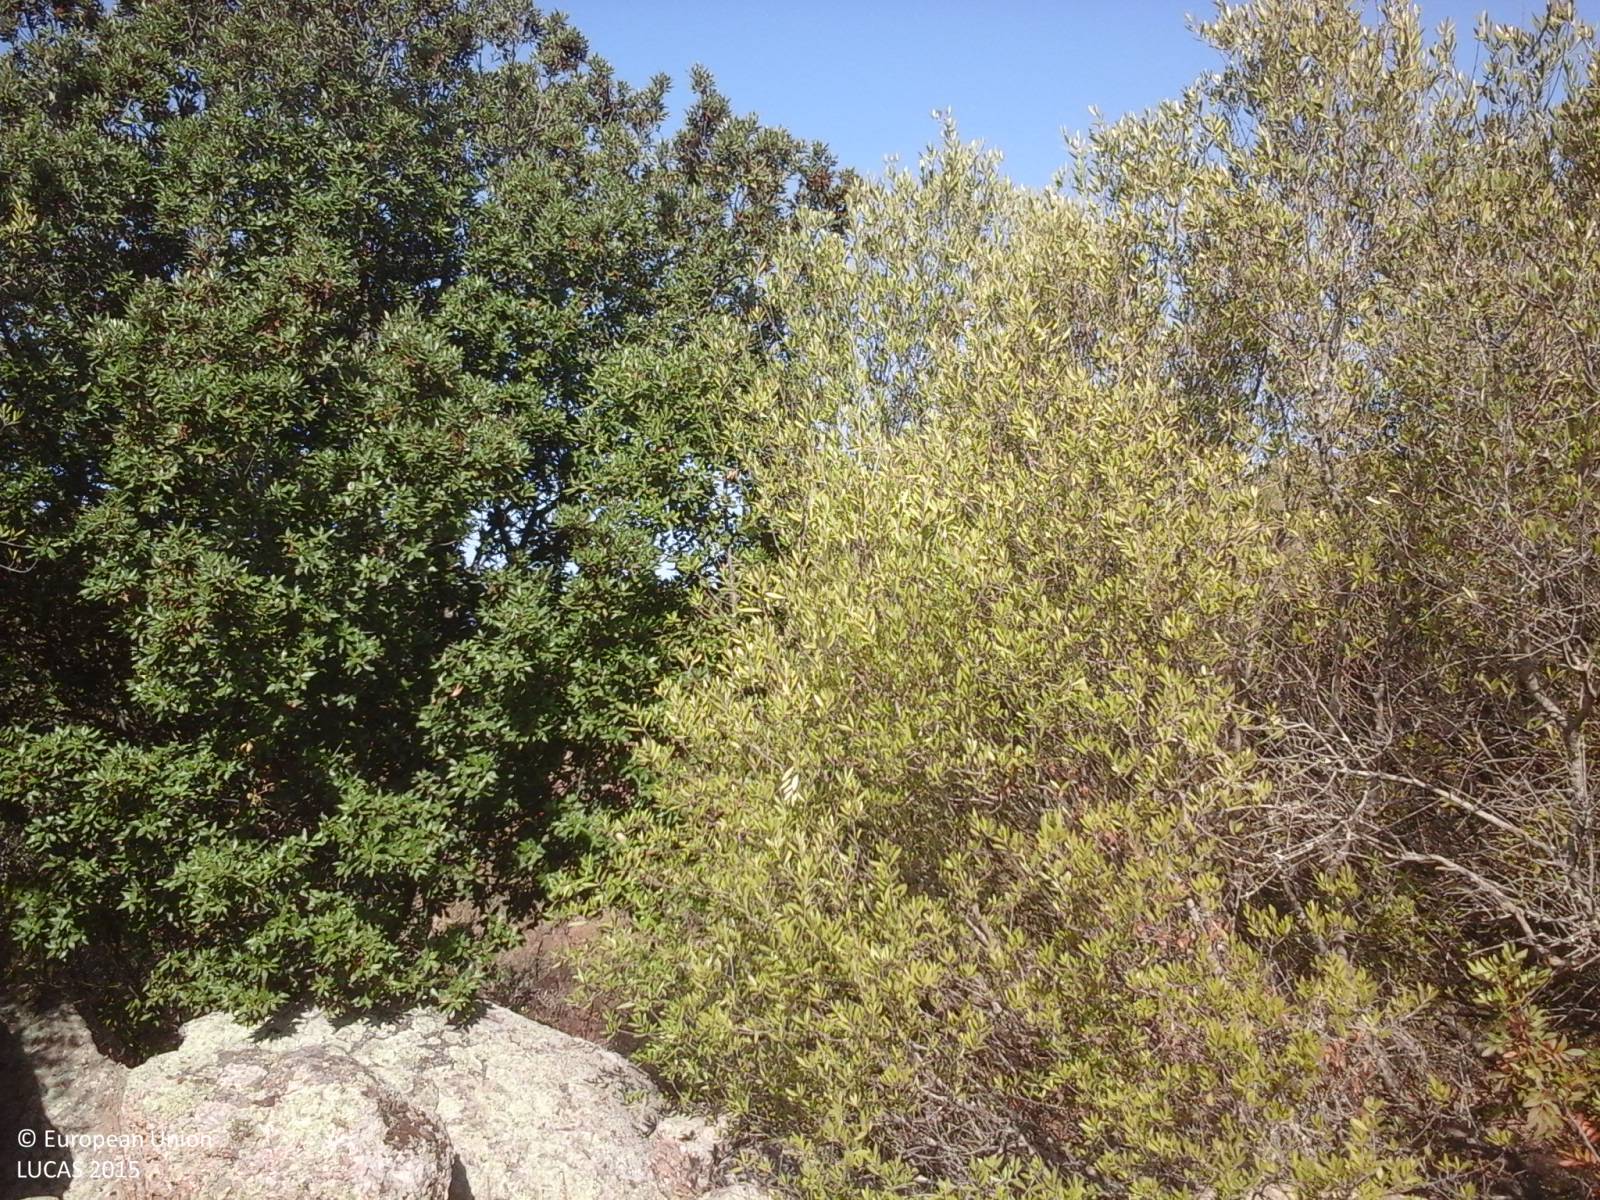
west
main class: Shrubland
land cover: Shrubland with sparse tree cover
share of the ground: > 75 %
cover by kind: shrubs 90 %, broadleaved forest trees 5 %, unconsolidated bare surface 5 %
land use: Semi-natural and natural areas not in use
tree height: > 5 m
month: September
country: IT
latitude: 41.0436
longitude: 9.3961
